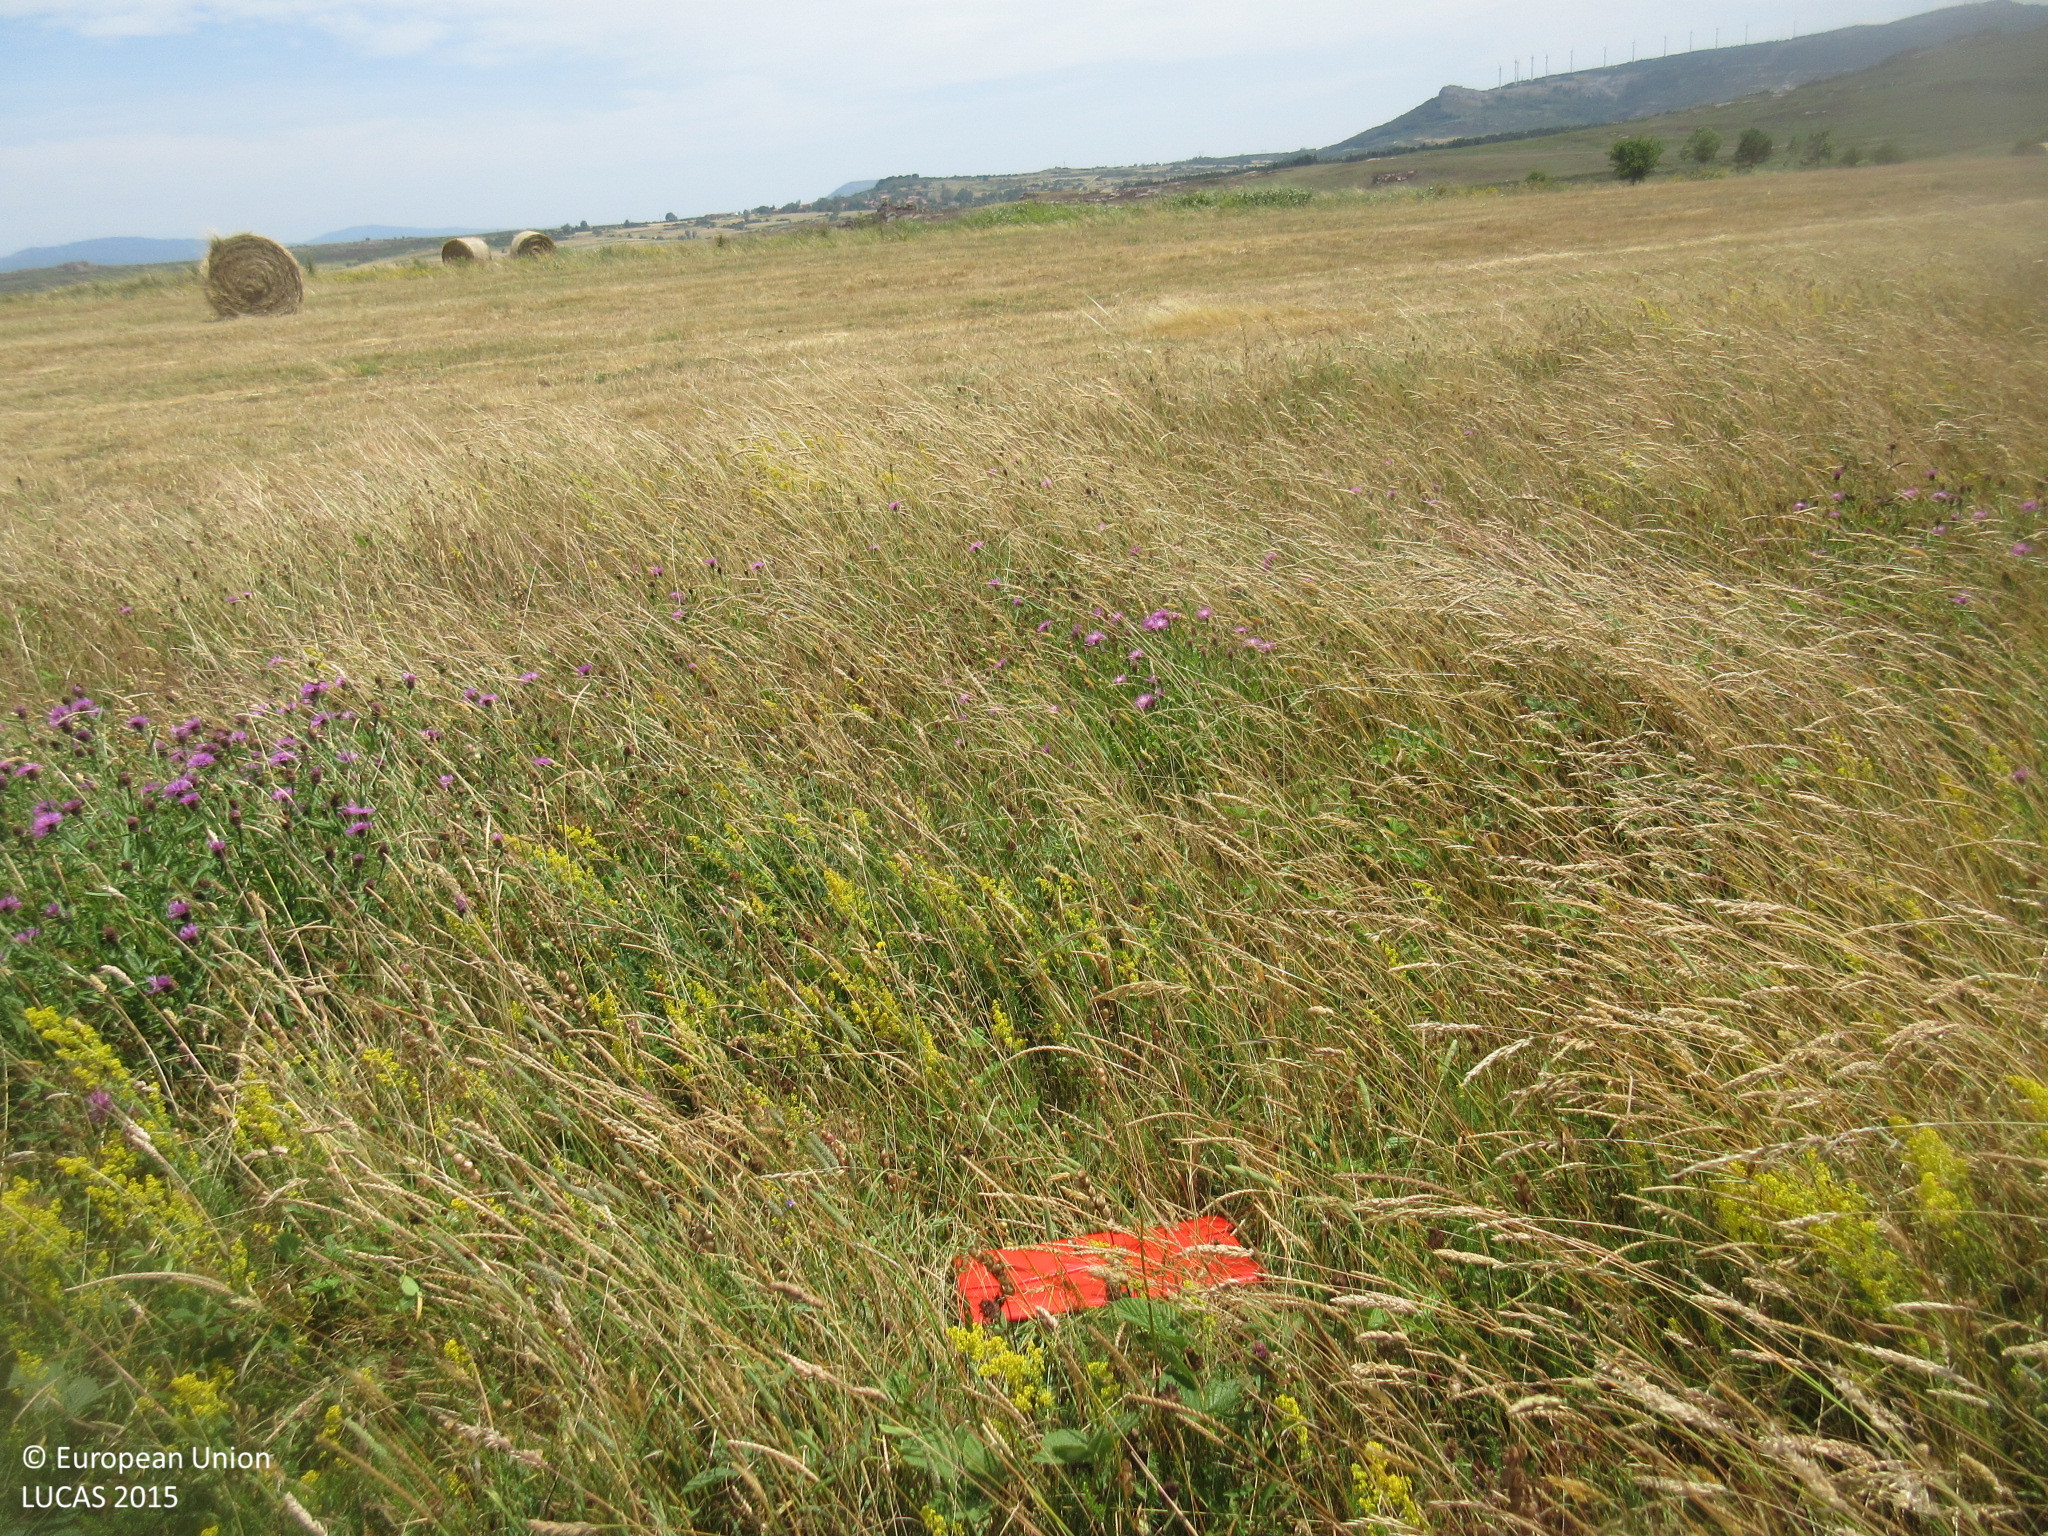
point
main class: Grassland
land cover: Spontaneously vegetated surfaces
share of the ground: > 75 %
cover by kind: herbaceous plants 100 %
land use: Agriculture (excluding fallow land and kitchen gardens)
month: July
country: ES
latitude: 42.9658
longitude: -3.9370
